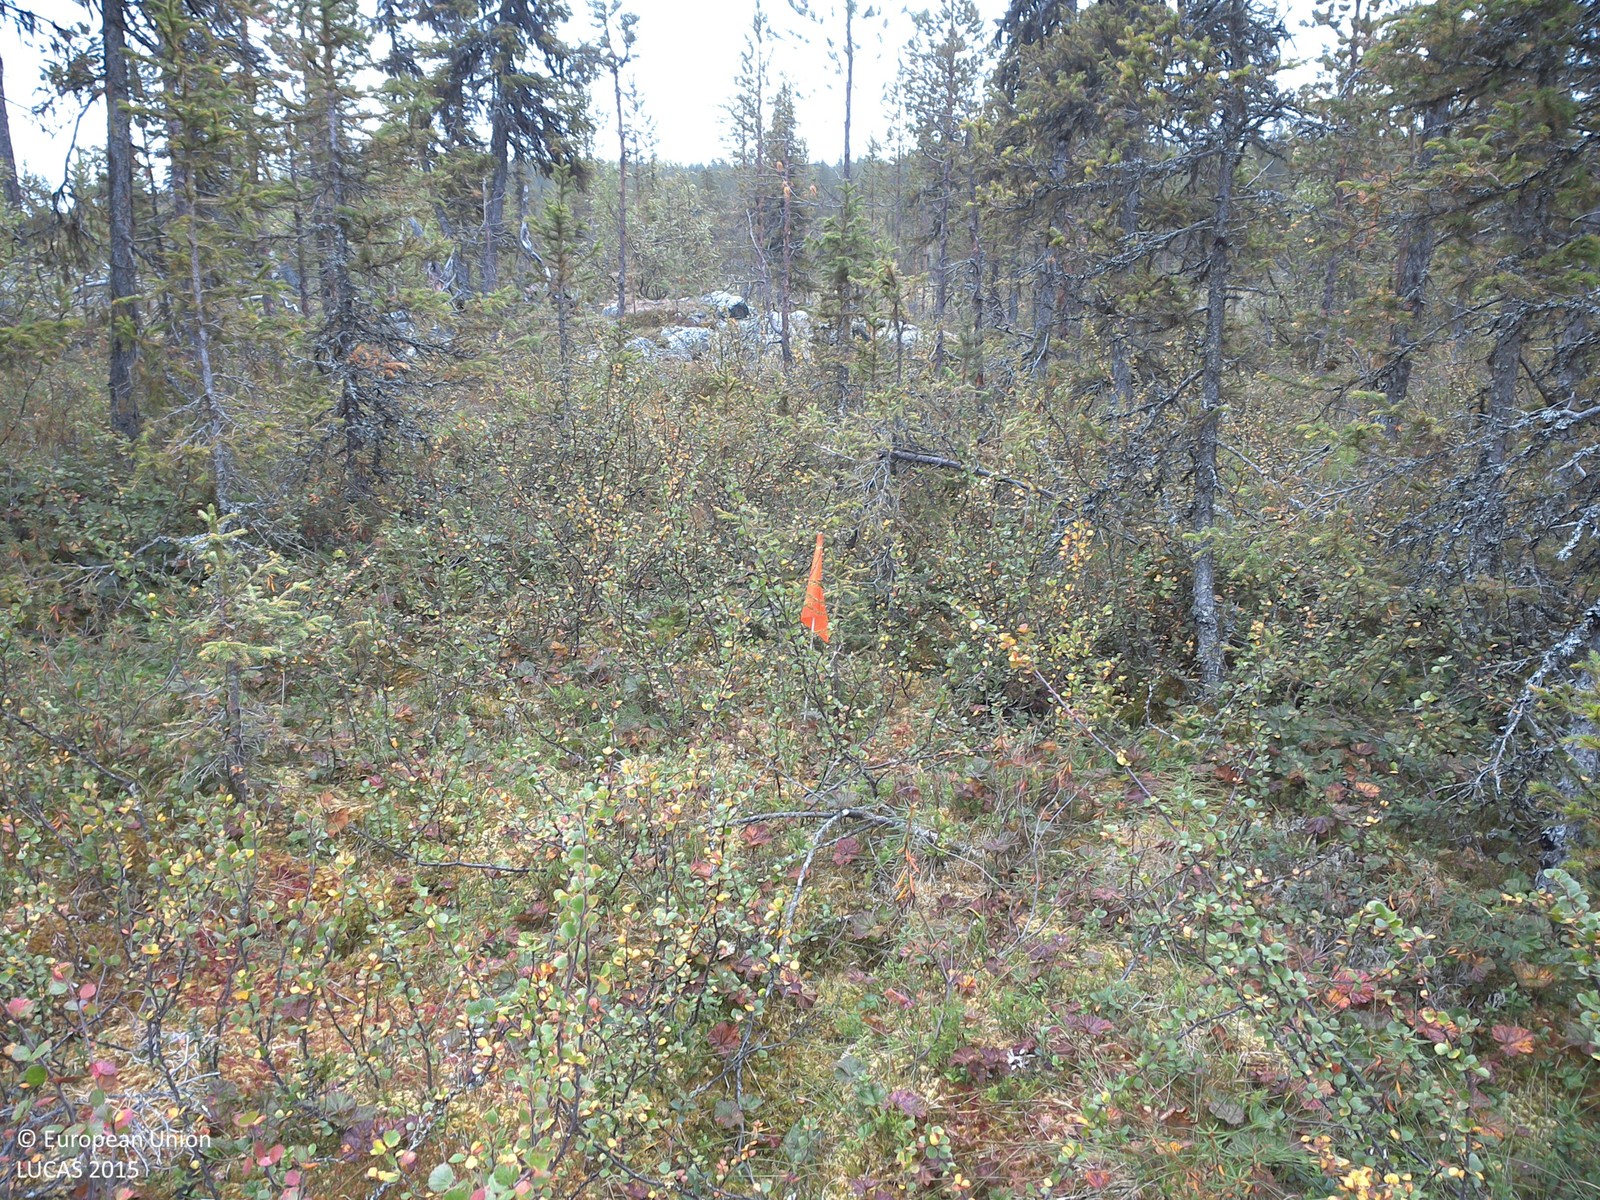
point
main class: Woodland
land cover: Spruce dominated coniferous woodland
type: boreal forest
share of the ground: 10 - 25 %
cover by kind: shrubs 60 %, coniferous forest trees 20 %, lichens and mosses 20 %
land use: Forestry
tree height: > 5 m
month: August
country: SE
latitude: 67.8295
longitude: 21.4618
